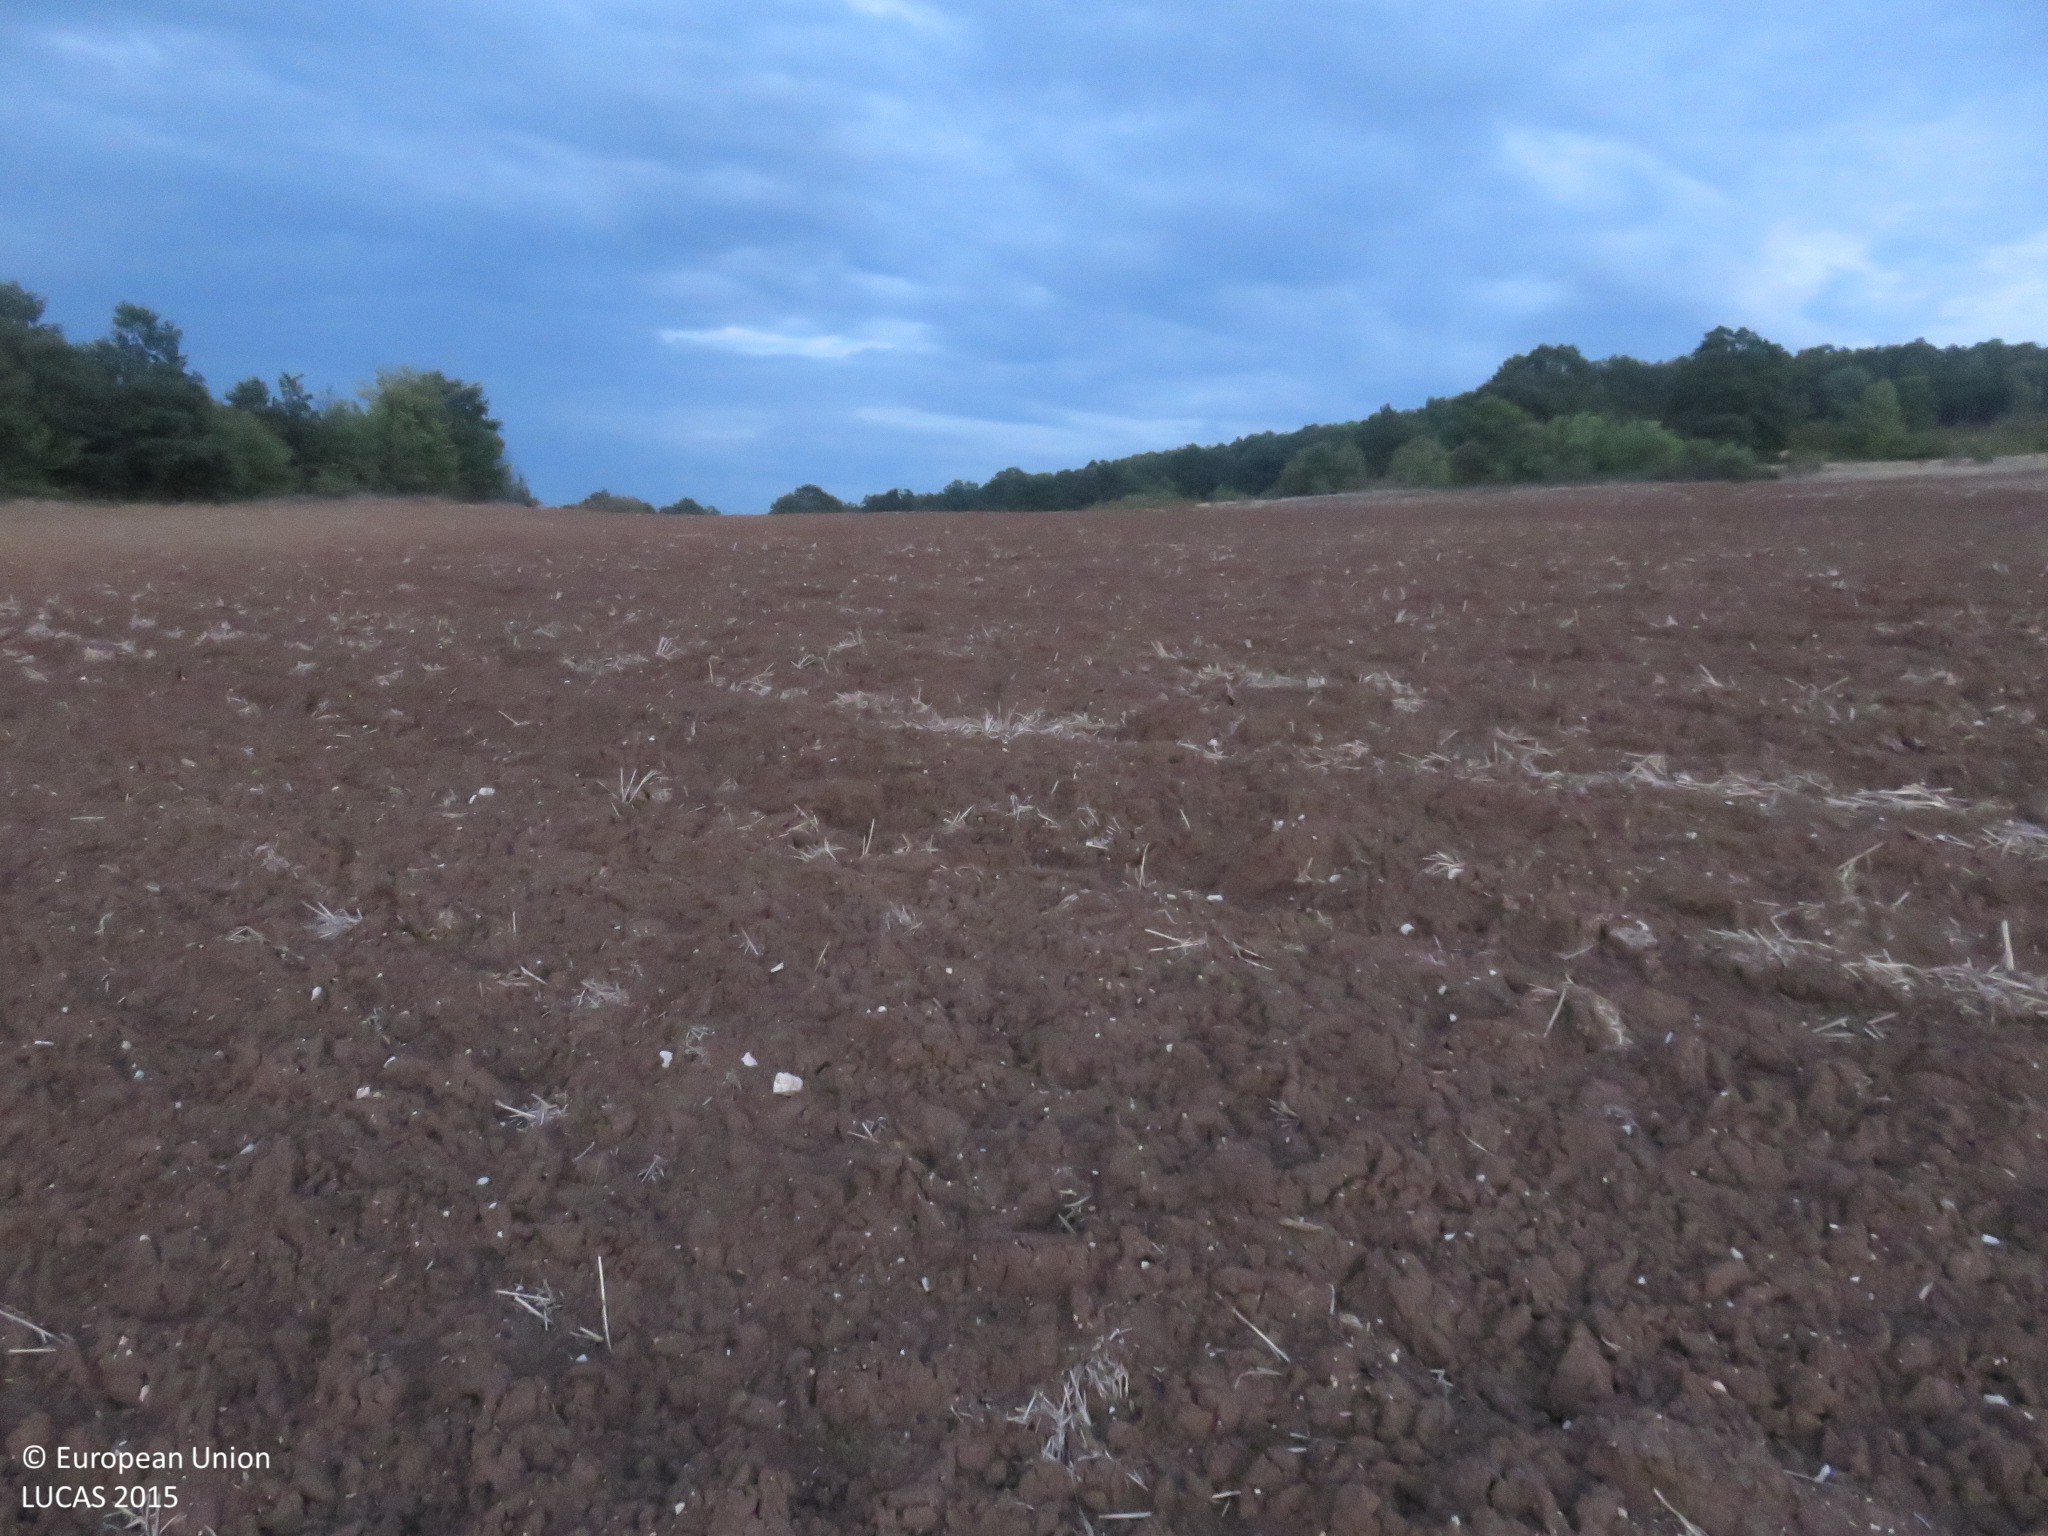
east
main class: Cropland
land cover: Common wheat
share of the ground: < 10 %
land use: Agriculture (excluding fallow land and kitchen gardens)
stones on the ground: < 10 %
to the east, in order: Common wheat
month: September
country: BG
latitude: 43.0679
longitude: 25.0119
